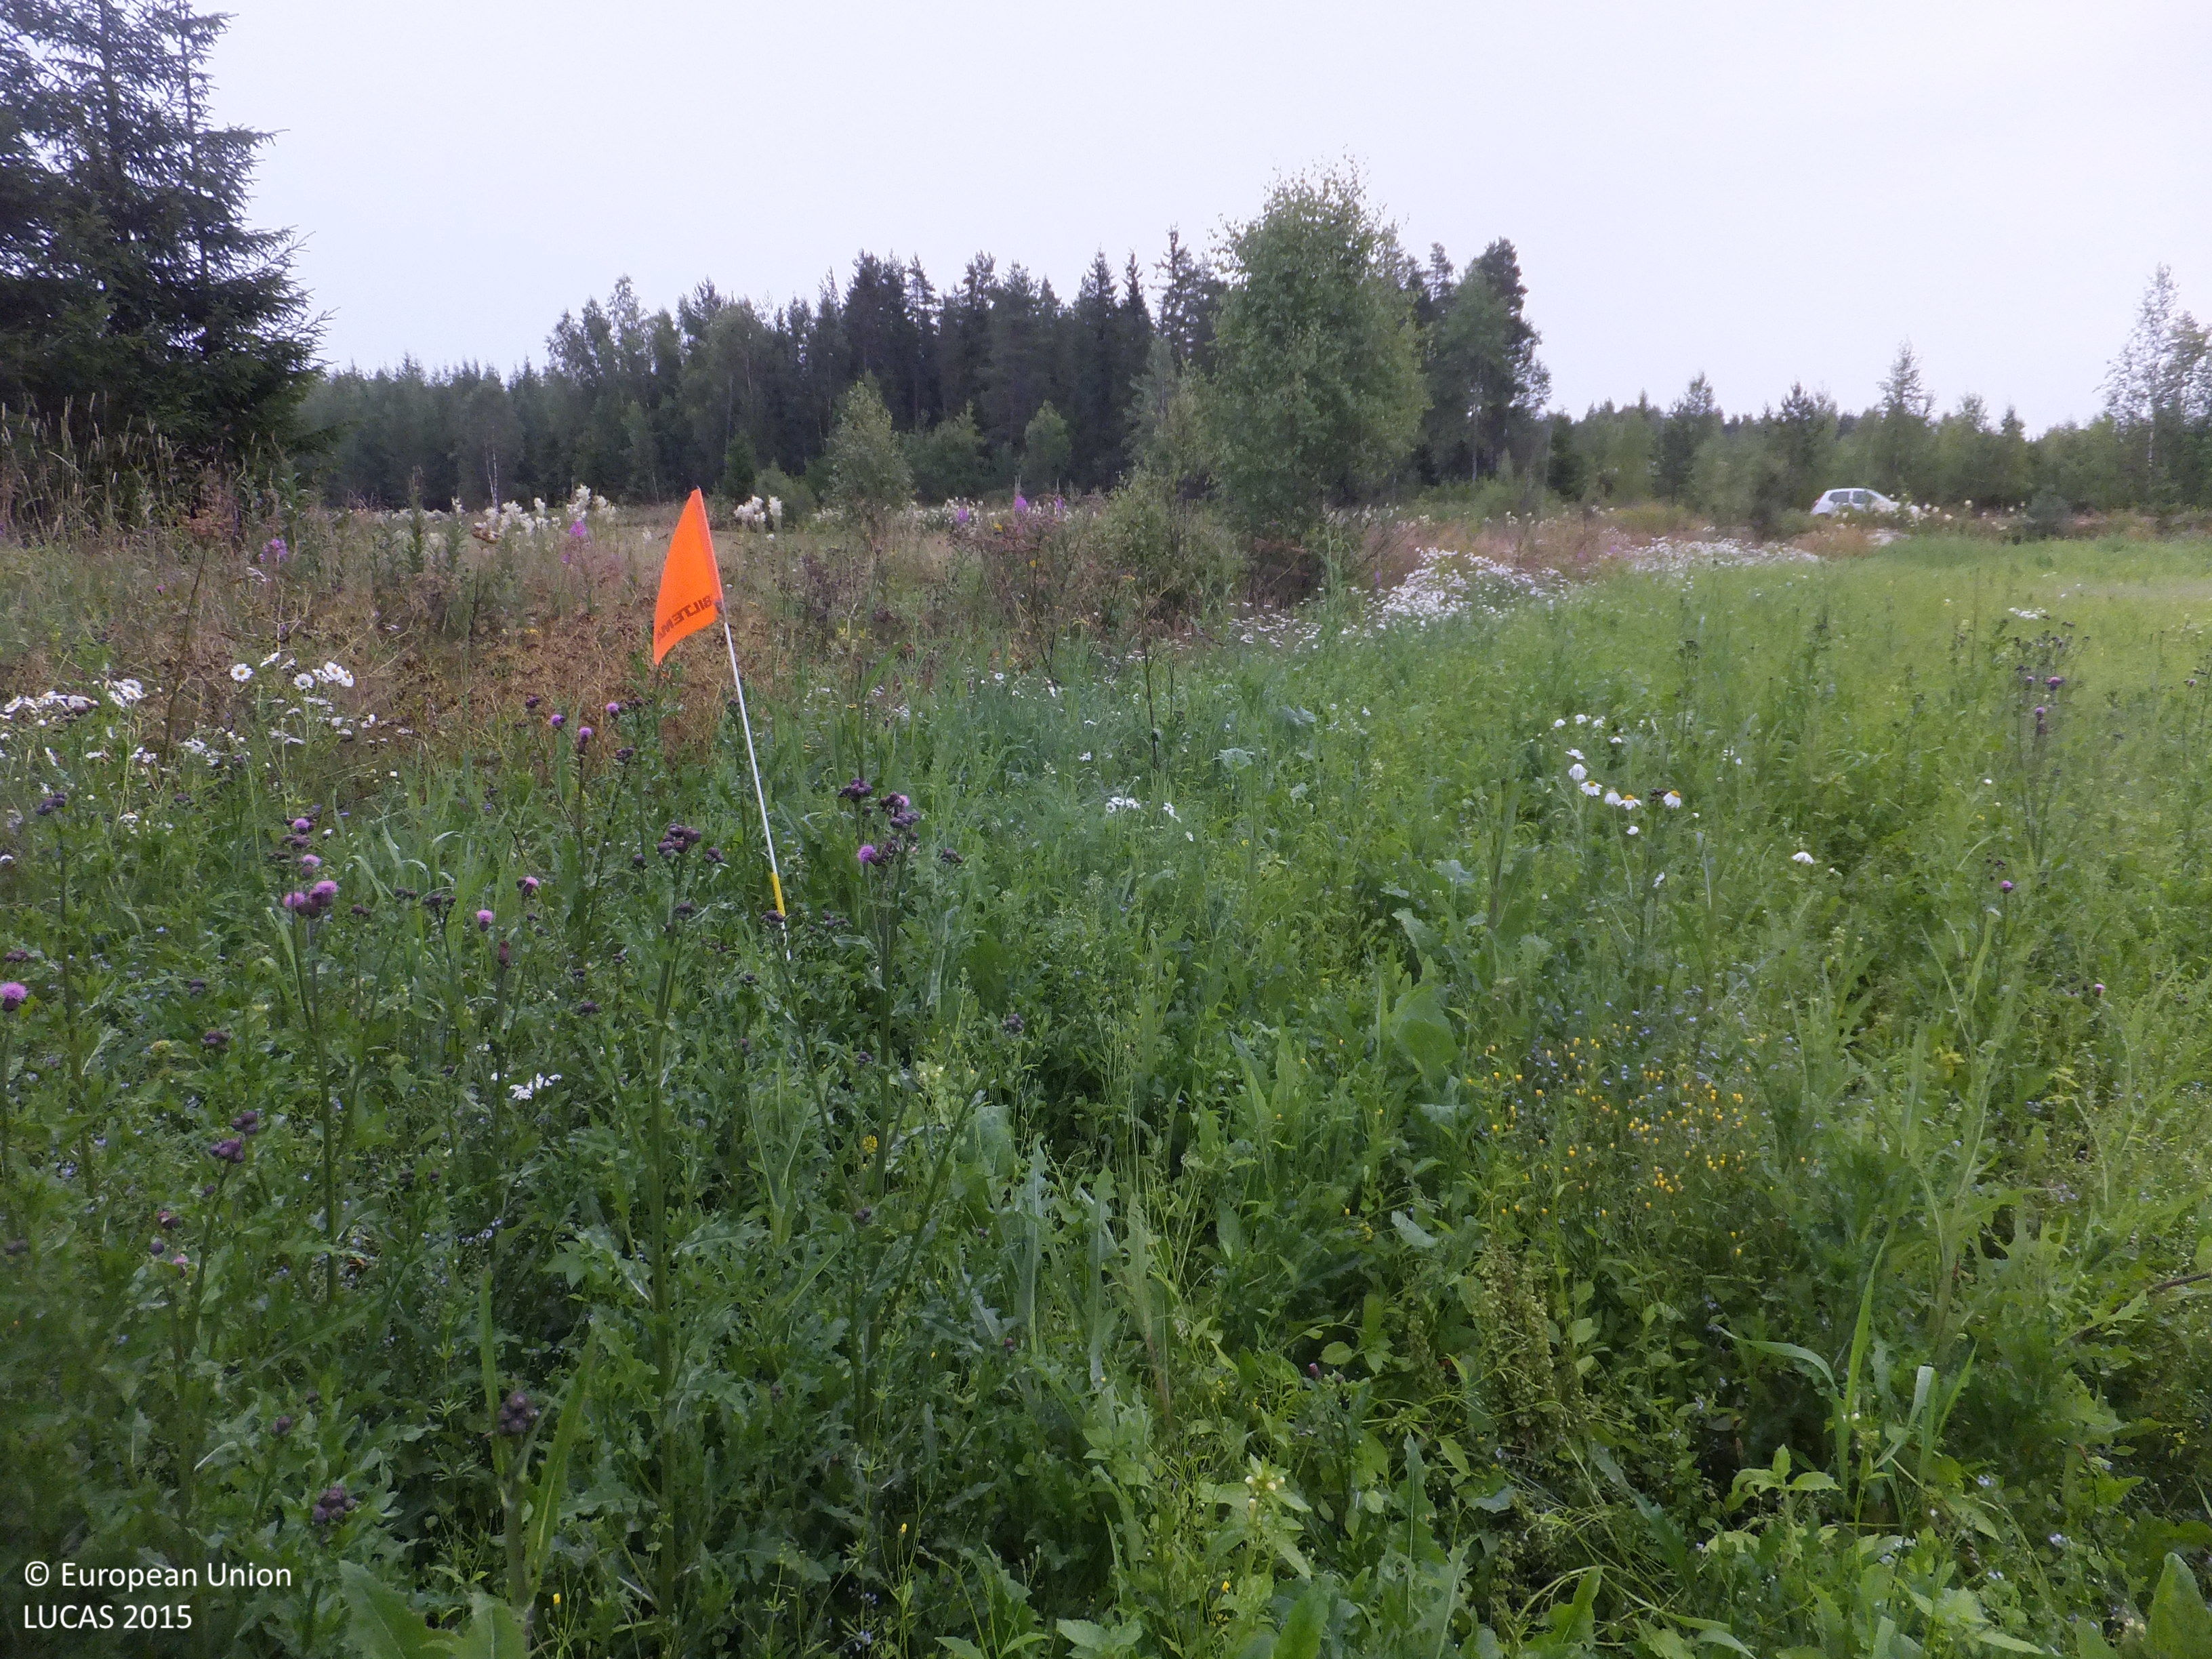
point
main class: Grassland
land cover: Grassland without tree/shrub cover
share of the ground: > 75 %
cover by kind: herbaceous plants 95 %, shrubs 5 %
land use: Agriculture (excluding fallow land and kitchen gardens)
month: July
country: FI
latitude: 63.0764
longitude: 22.0611
